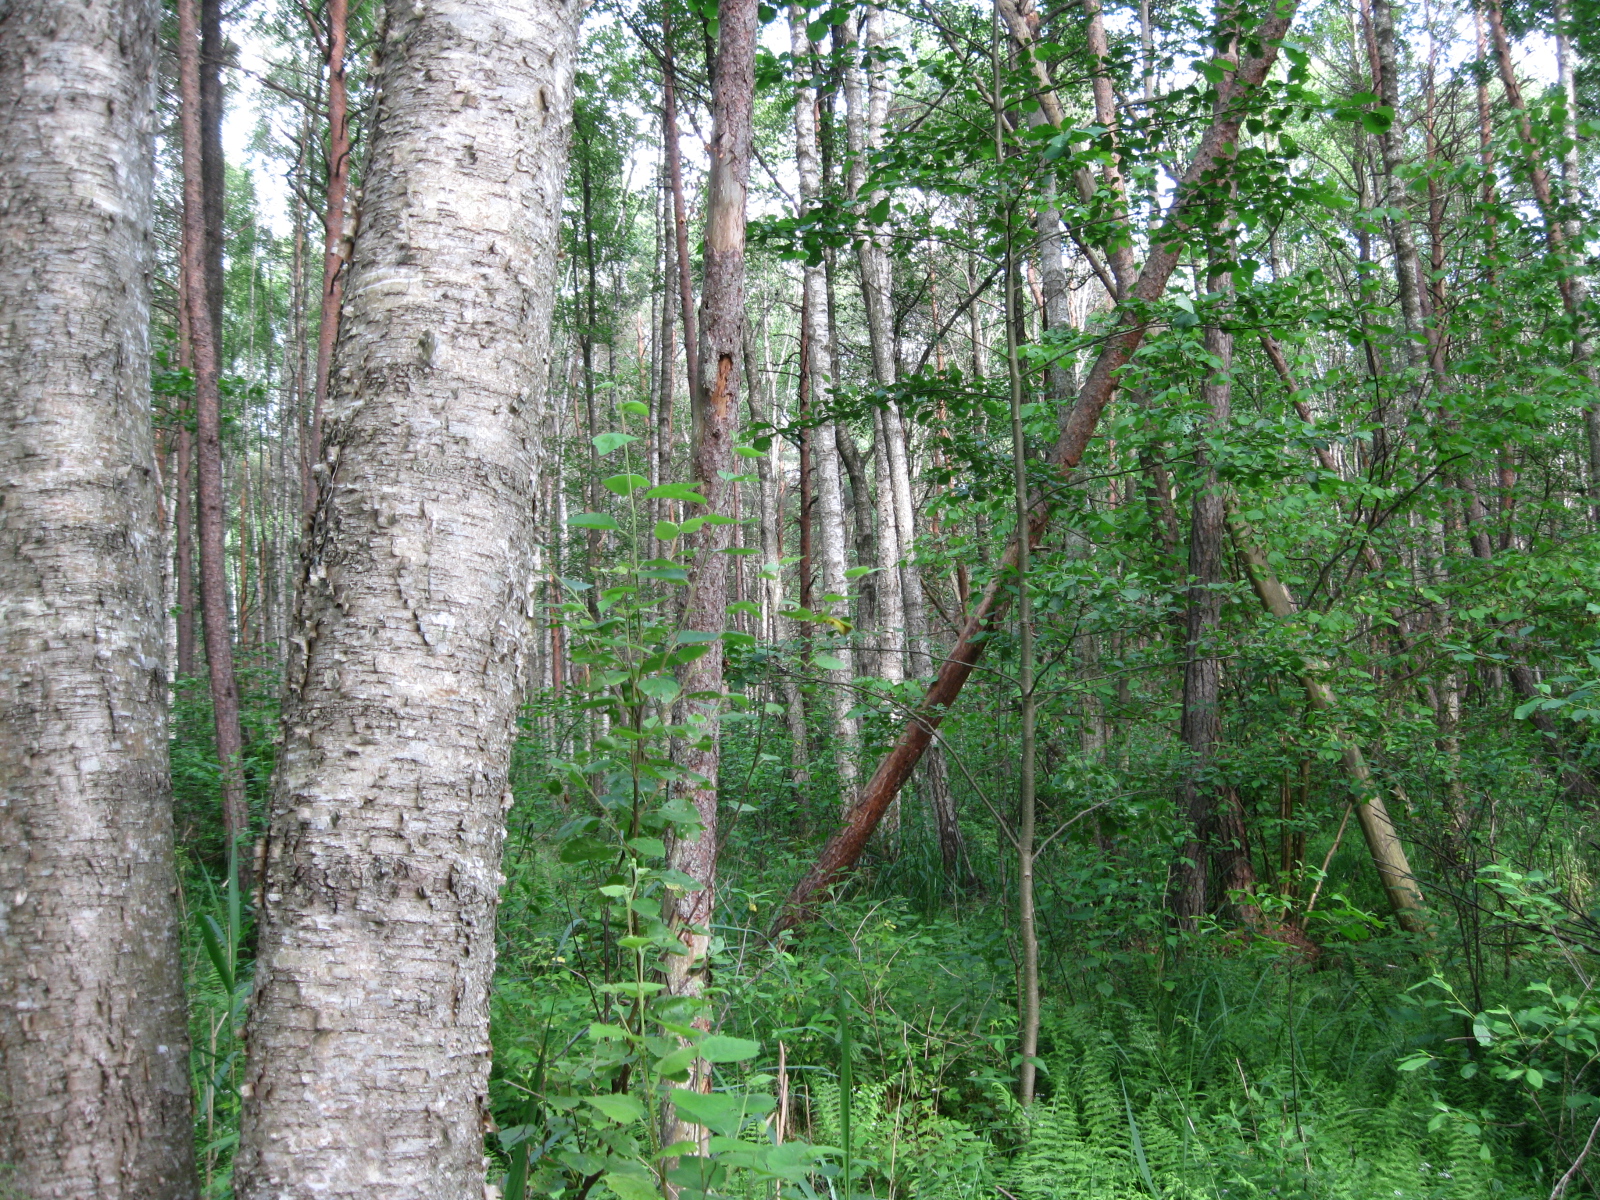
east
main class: Woodland
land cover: Pine dominated mixed woodland
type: hemiboreal forest and nemoral coniferous forest and mixed broadleaved-coniferous forest
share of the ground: > 75 %
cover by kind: broadleaved forest trees 50 %, coniferous forest trees 35 %, herbaceous plants 15 %
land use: Forestry
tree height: > 5 m
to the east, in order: Pine dominated mixed woodland; Spruce dominated coniferous woodland
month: June
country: LT
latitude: 55.5549
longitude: 24.2185
